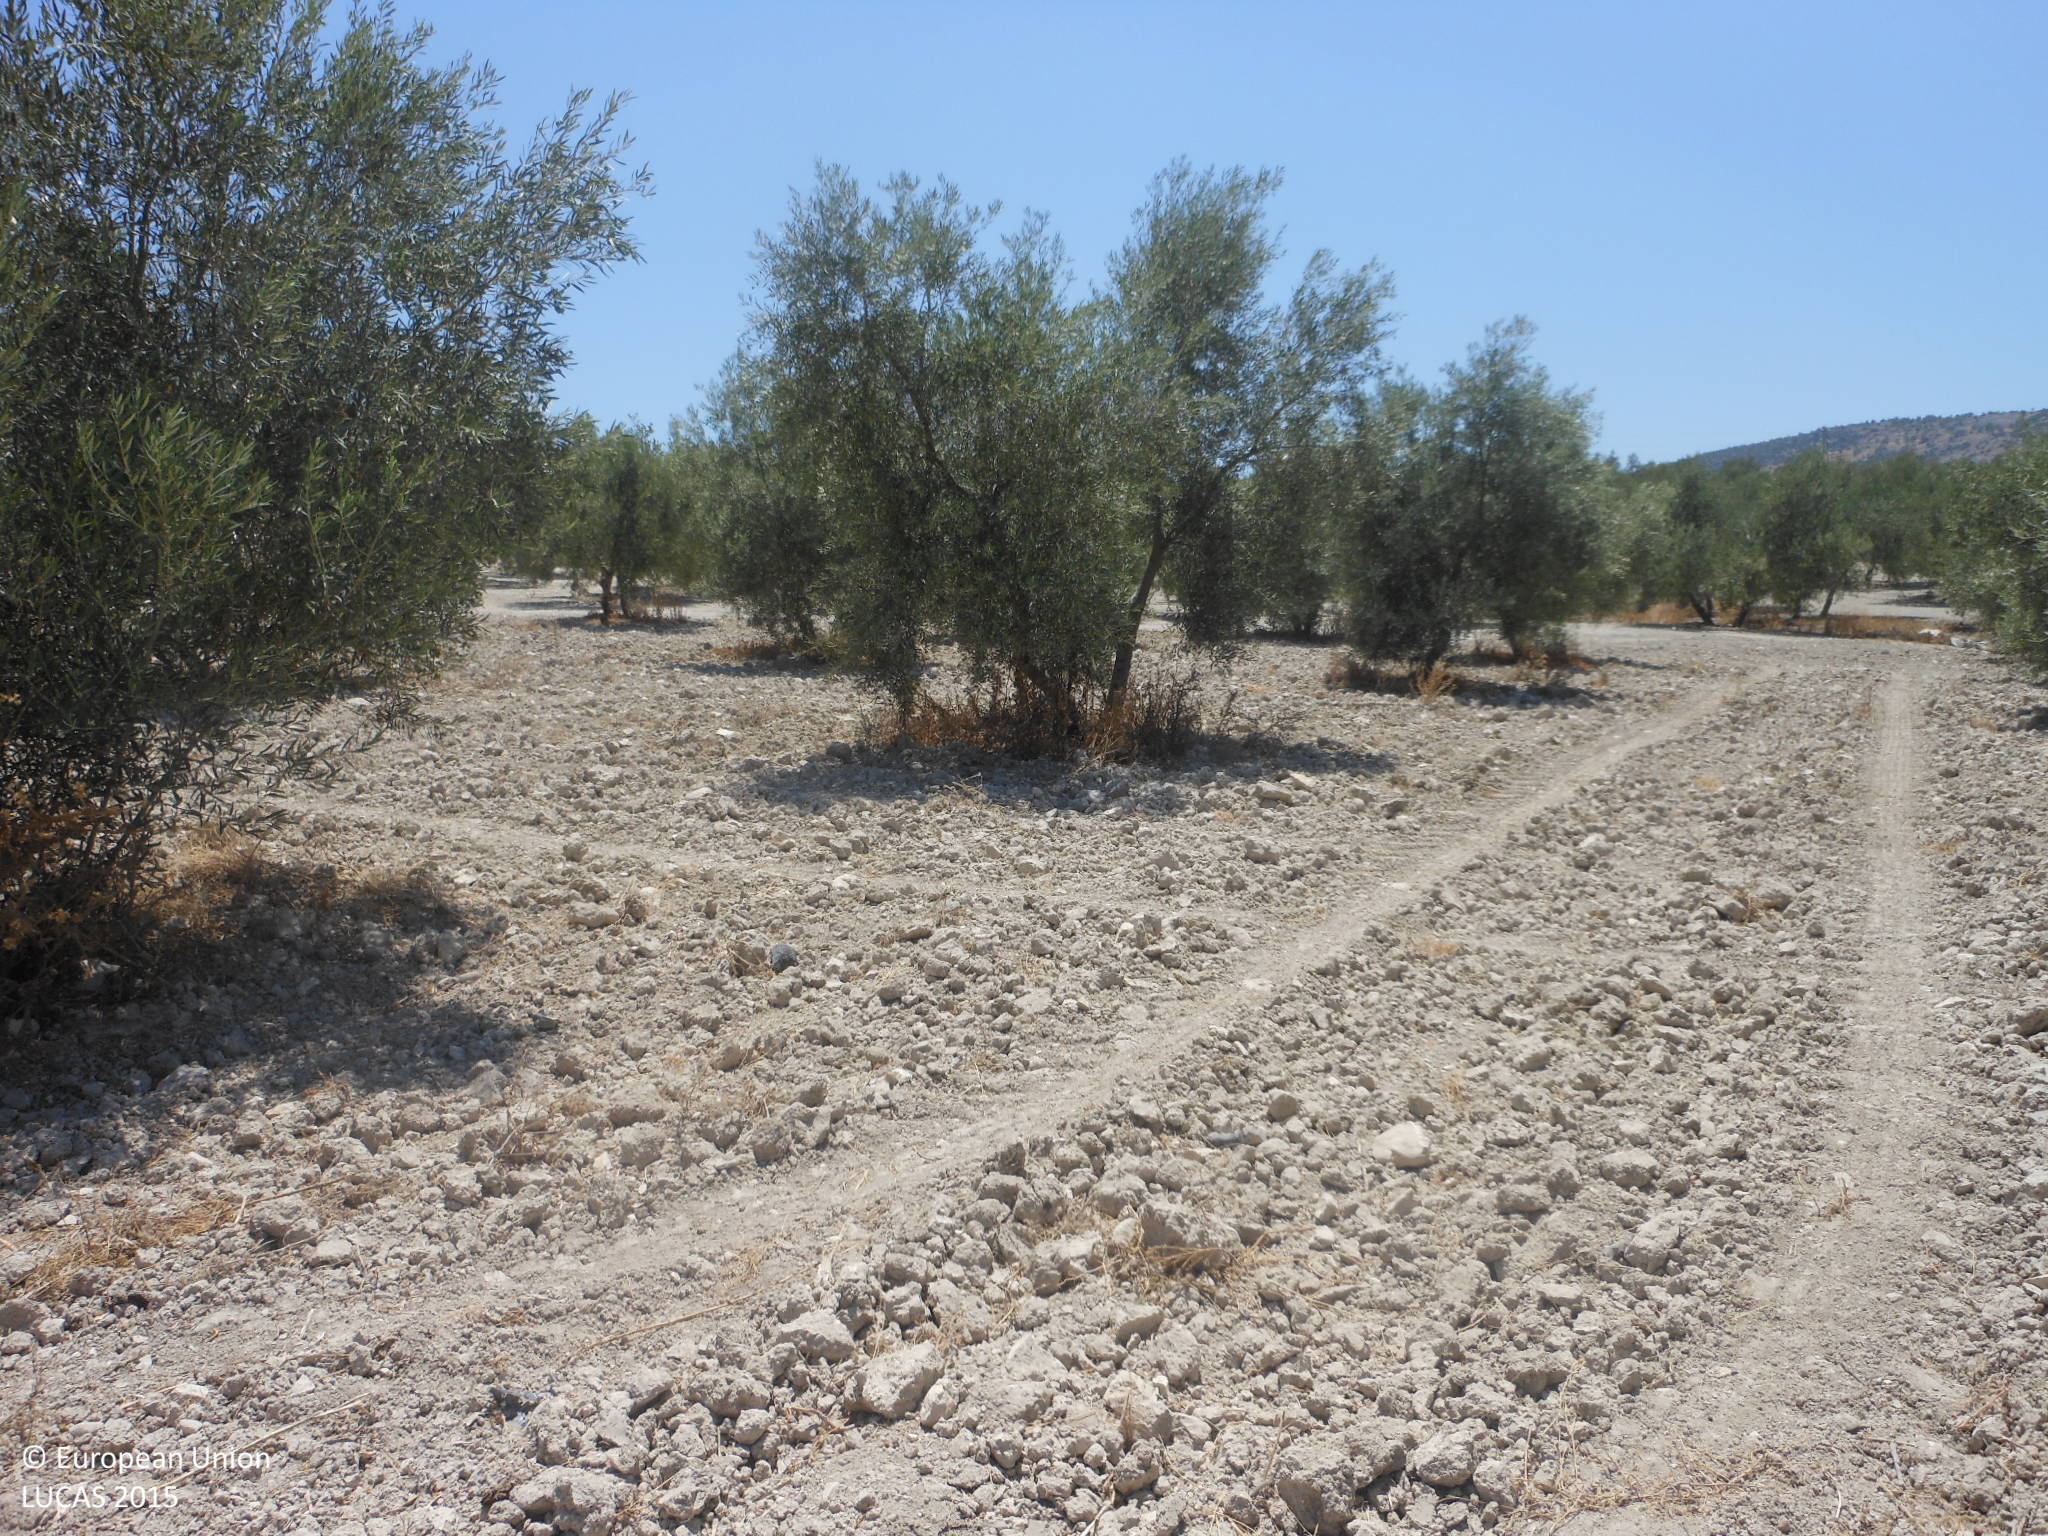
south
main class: Cropland
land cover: Olive groves
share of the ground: 25 - 50 %
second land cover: Other bare soil
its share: > 75 %
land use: Agriculture (excluding fallow land and kitchen gardens)
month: June
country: ES
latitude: 37.3047
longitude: -4.8871
